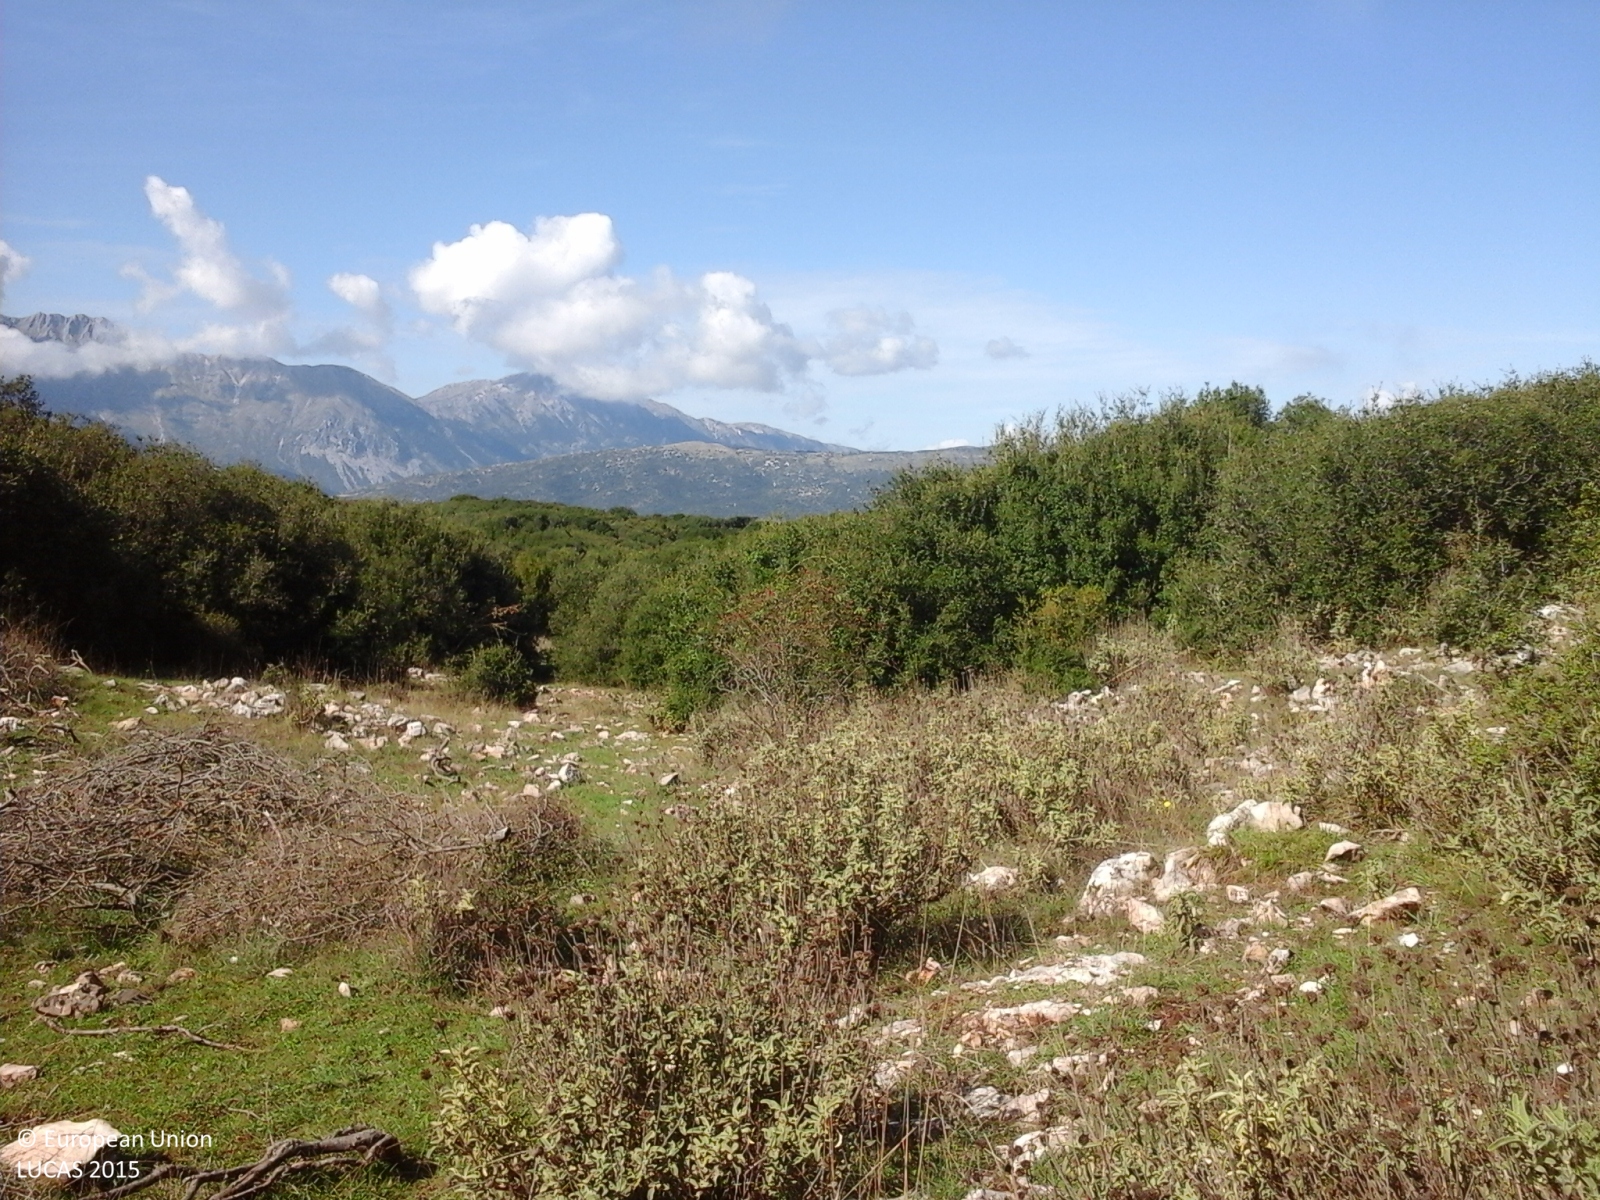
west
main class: Shrubland
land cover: Shrubland without tree cover
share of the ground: 50 - 75 %
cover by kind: shrubs 60 %, herbaceous plants 30 %, unconsolidated bare surface 10 %
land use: Agriculture (excluding fallow land and kitchen gardens)
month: October
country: GR
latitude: 39.5097
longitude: 20.9216
